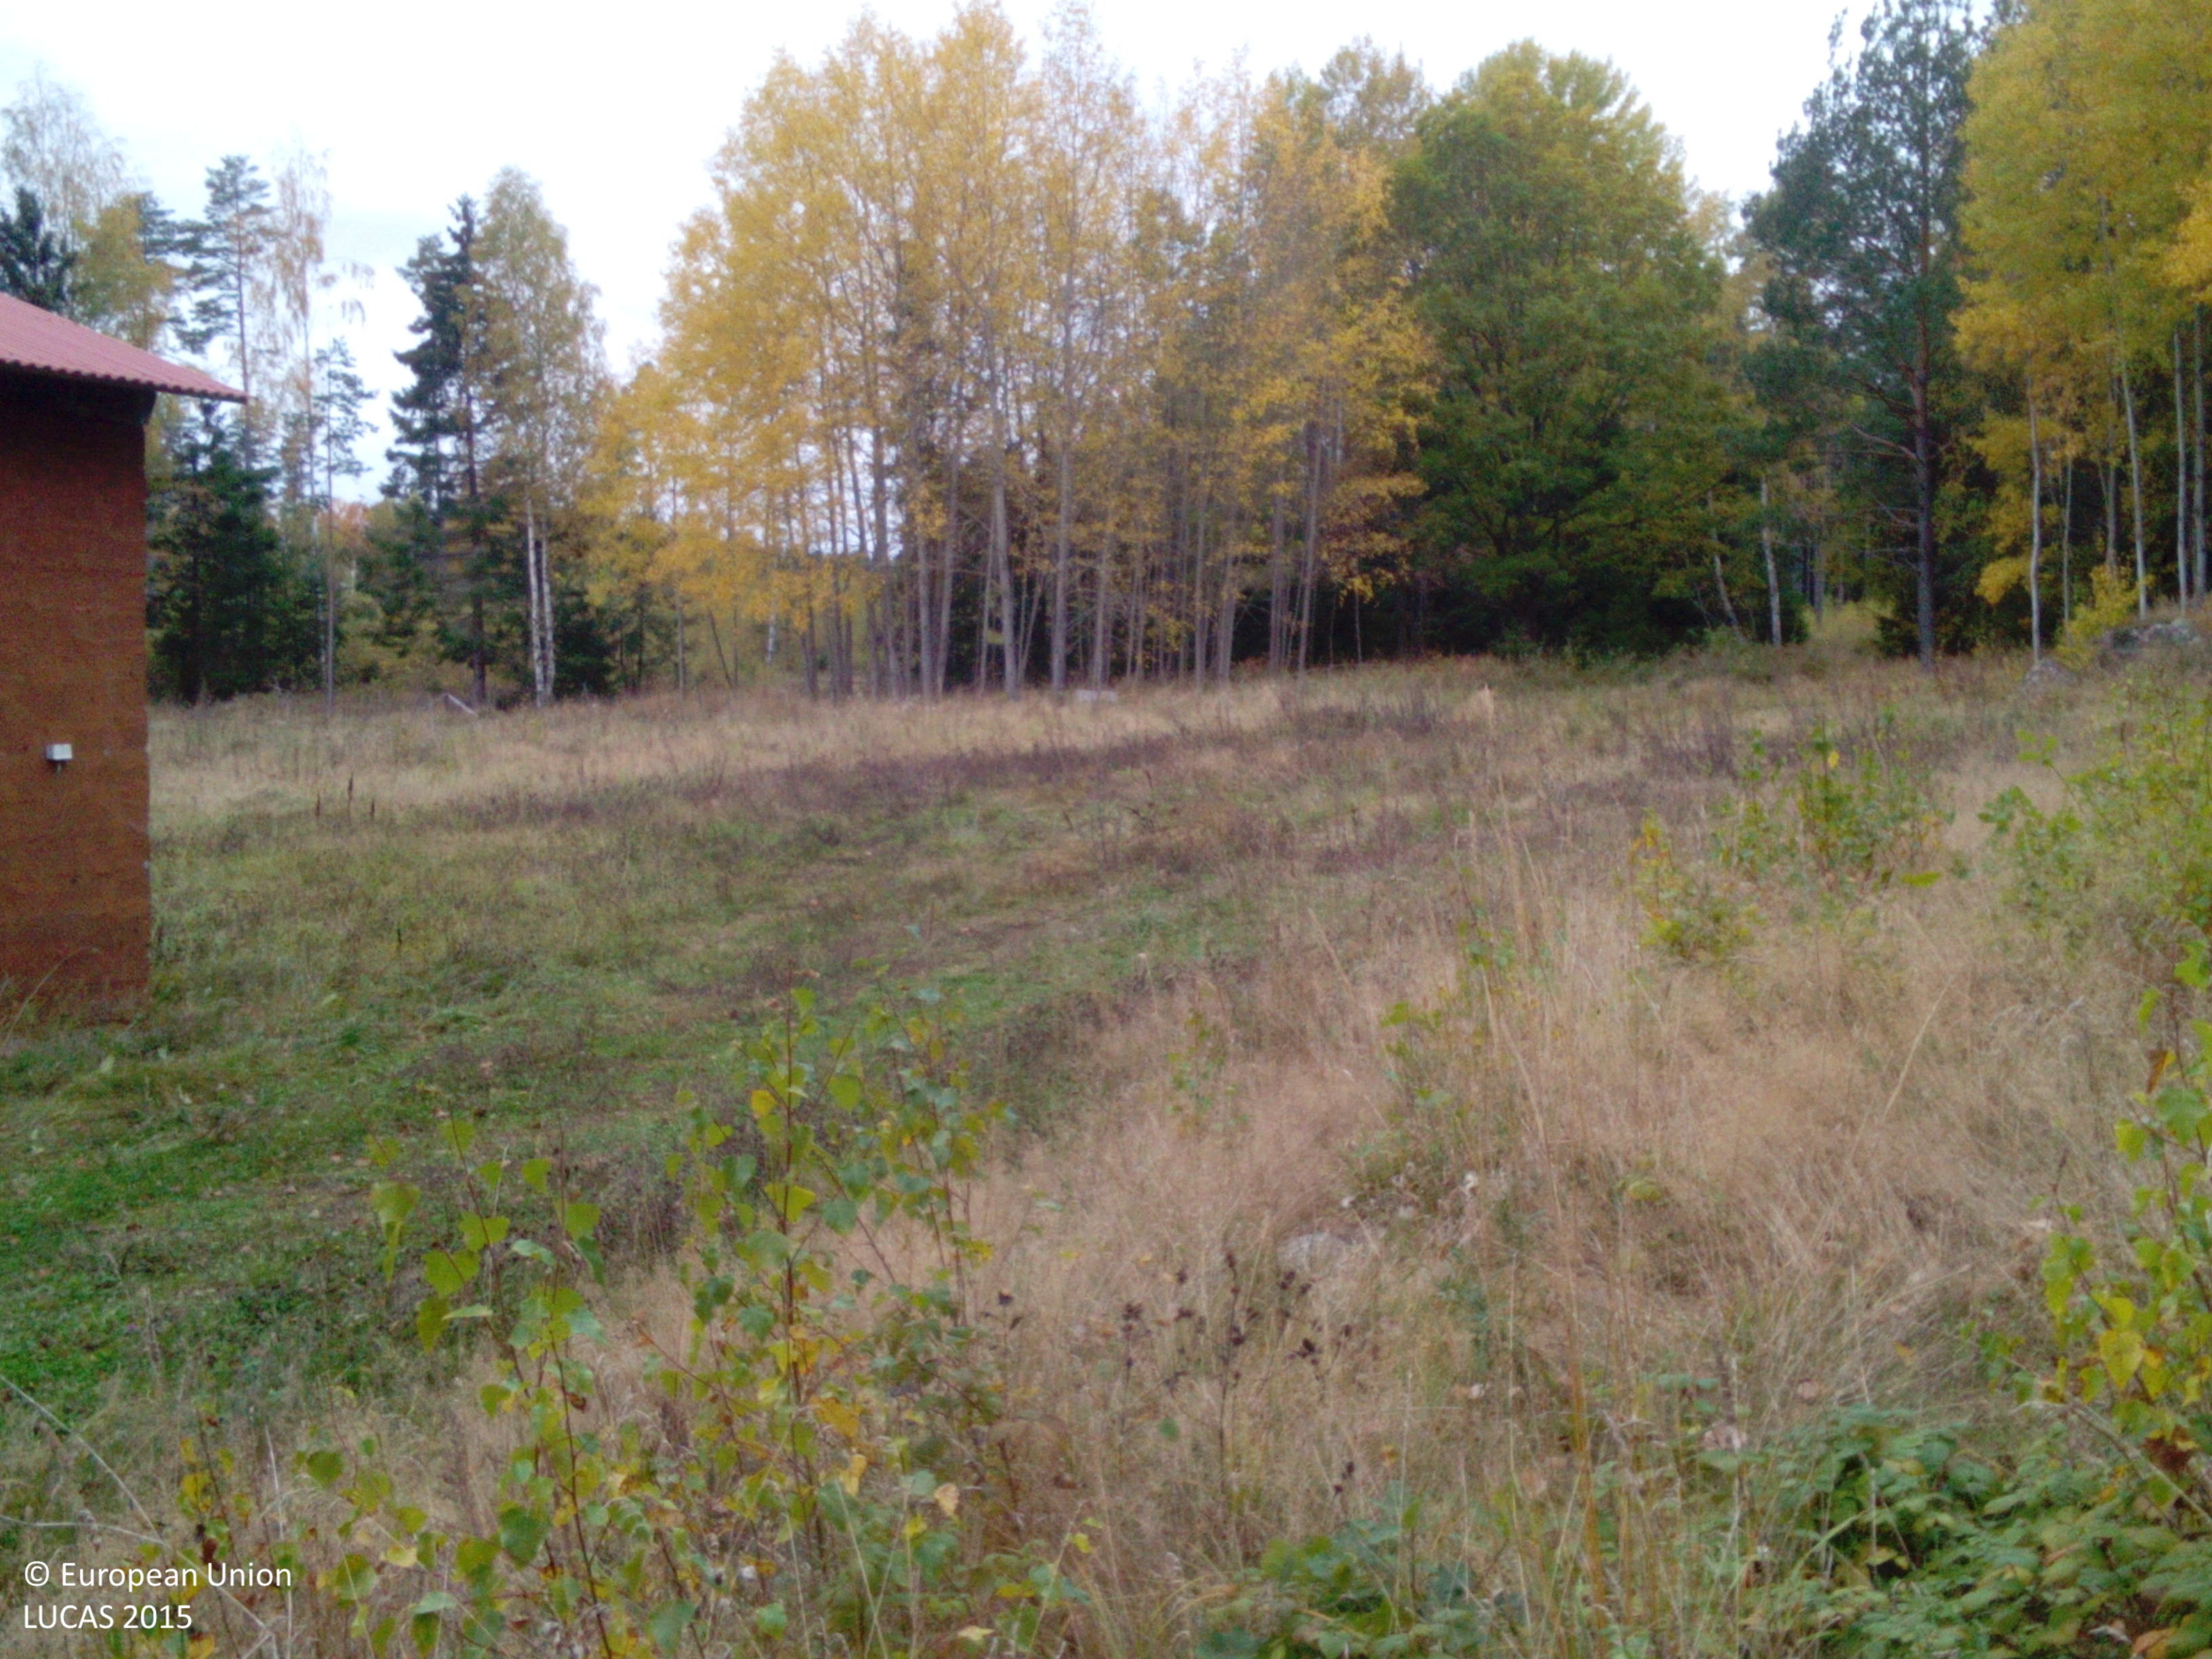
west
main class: Shrubland
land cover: Shrubland with sparse tree cover
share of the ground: 25 - 50 %
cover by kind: shrubs 45 %, herbaceous plants 40 %, broadleaved forest trees 5 %
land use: Semi-natural and natural areas not in use
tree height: < 5 m
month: October
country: SE
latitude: 58.8569
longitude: 16.4957
